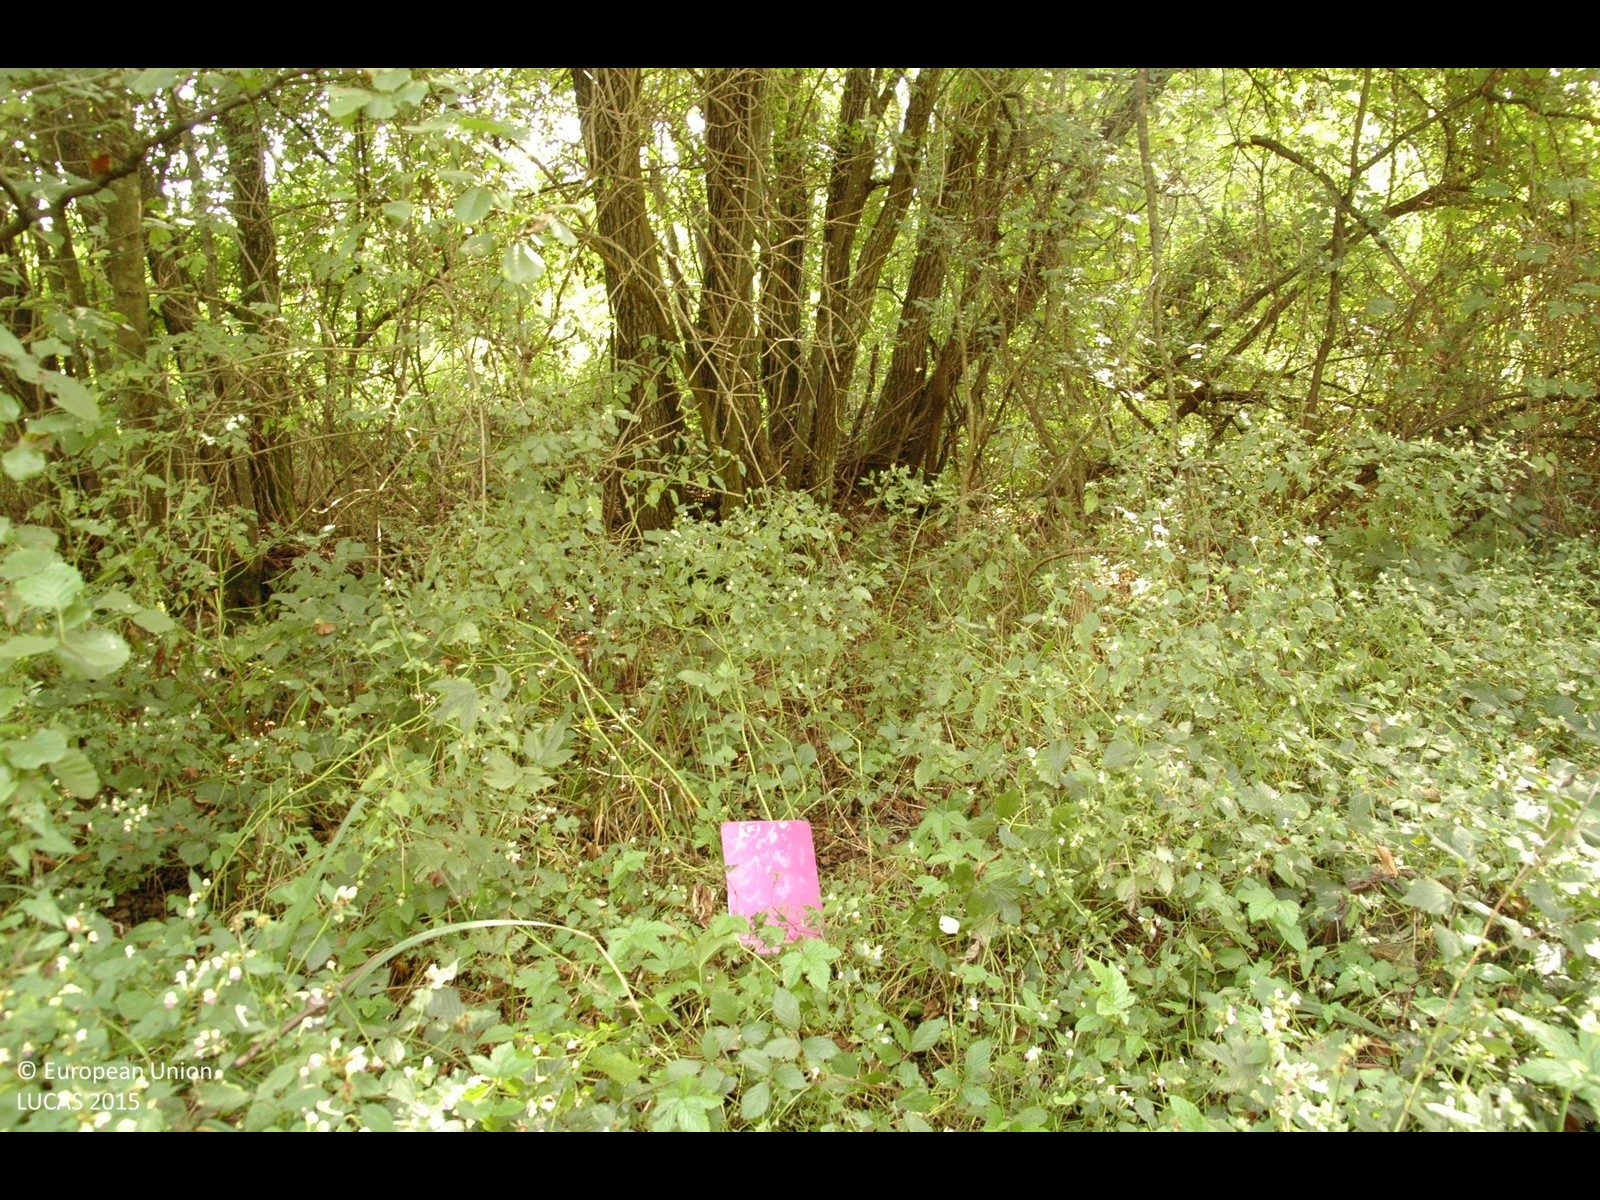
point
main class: Woodland
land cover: Broadleaved woodland
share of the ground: > 75 %
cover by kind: broadleaved forest trees 100 %
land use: Forestry
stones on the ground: < 10 %
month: September
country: HR
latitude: 45.5711
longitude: 15.9556
